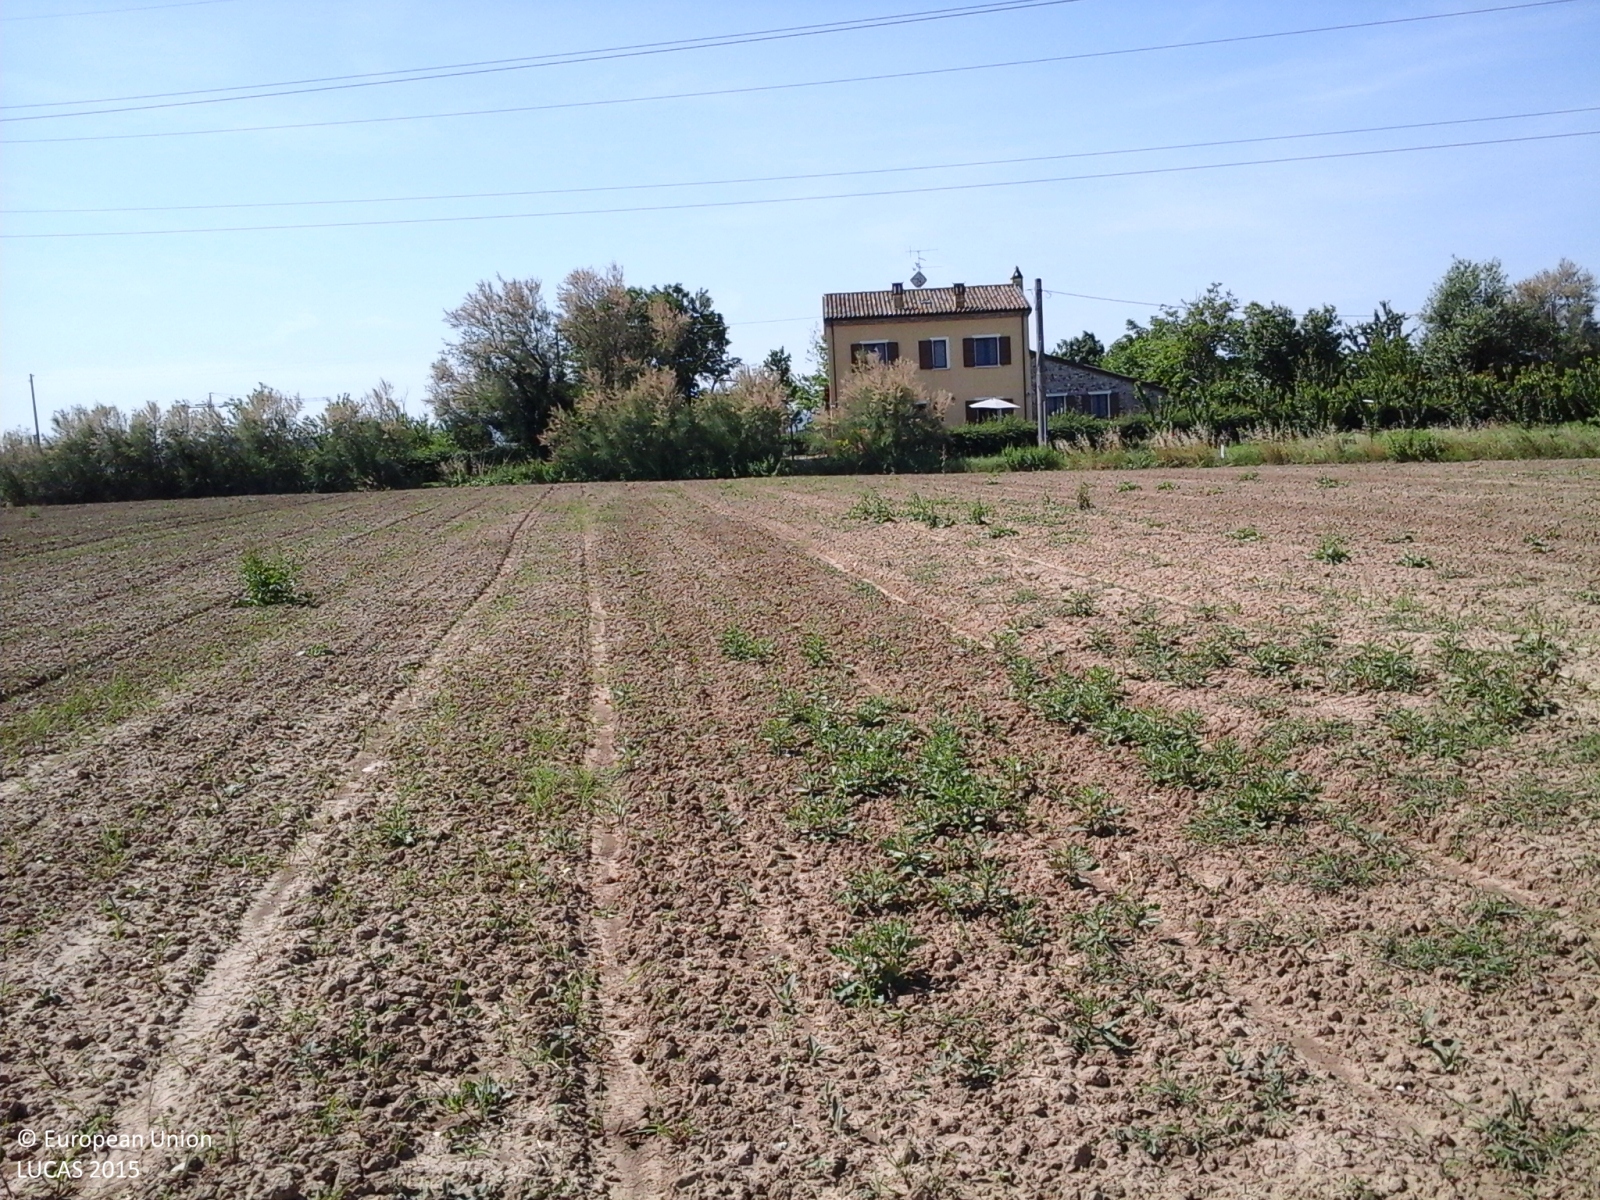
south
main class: Cropland
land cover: Other fresh vegetables
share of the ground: > 75 %
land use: Agriculture (excluding fallow land and kitchen gardens)
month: May
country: IT
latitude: 44.0875
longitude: 12.4299
